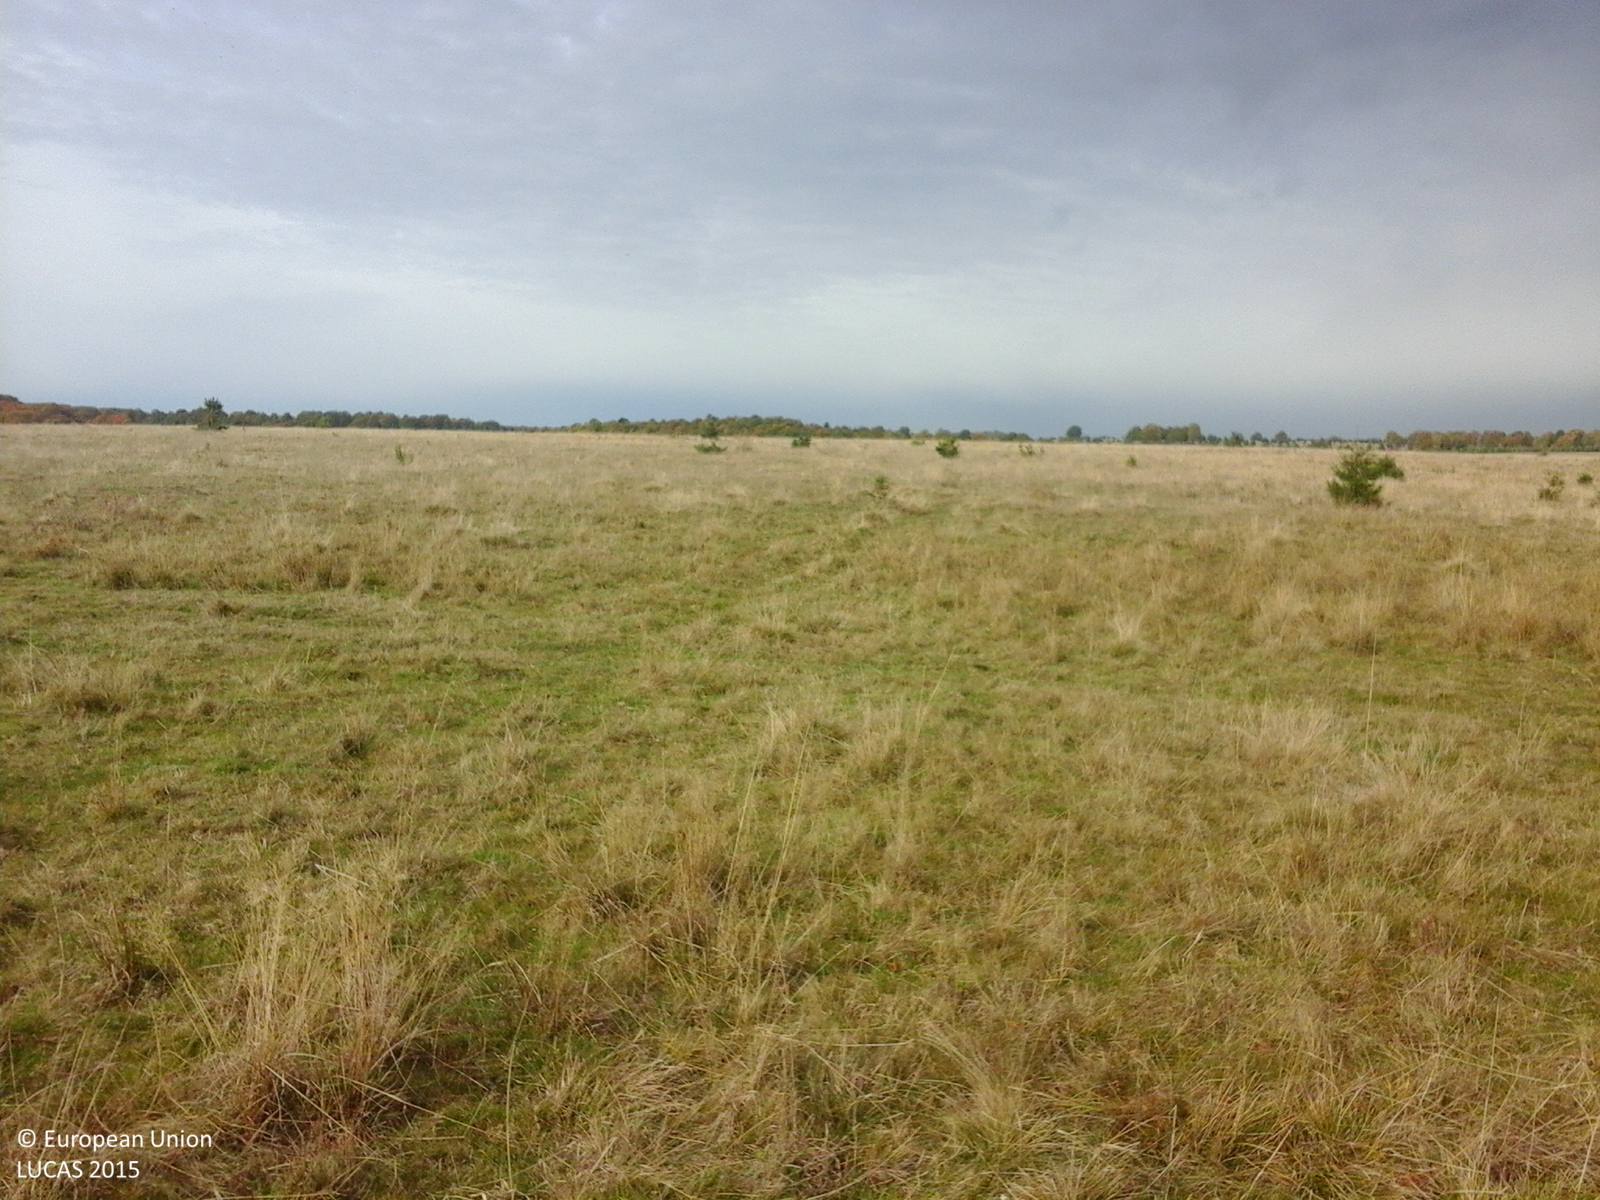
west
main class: Grassland
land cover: Grassland without tree/shrub cover
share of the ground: > 75 %
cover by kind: herbaceous plants 100 %
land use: Agriculture (excluding fallow land and kitchen gardens)
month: October
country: RO
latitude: 46.4268
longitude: 25.3426
